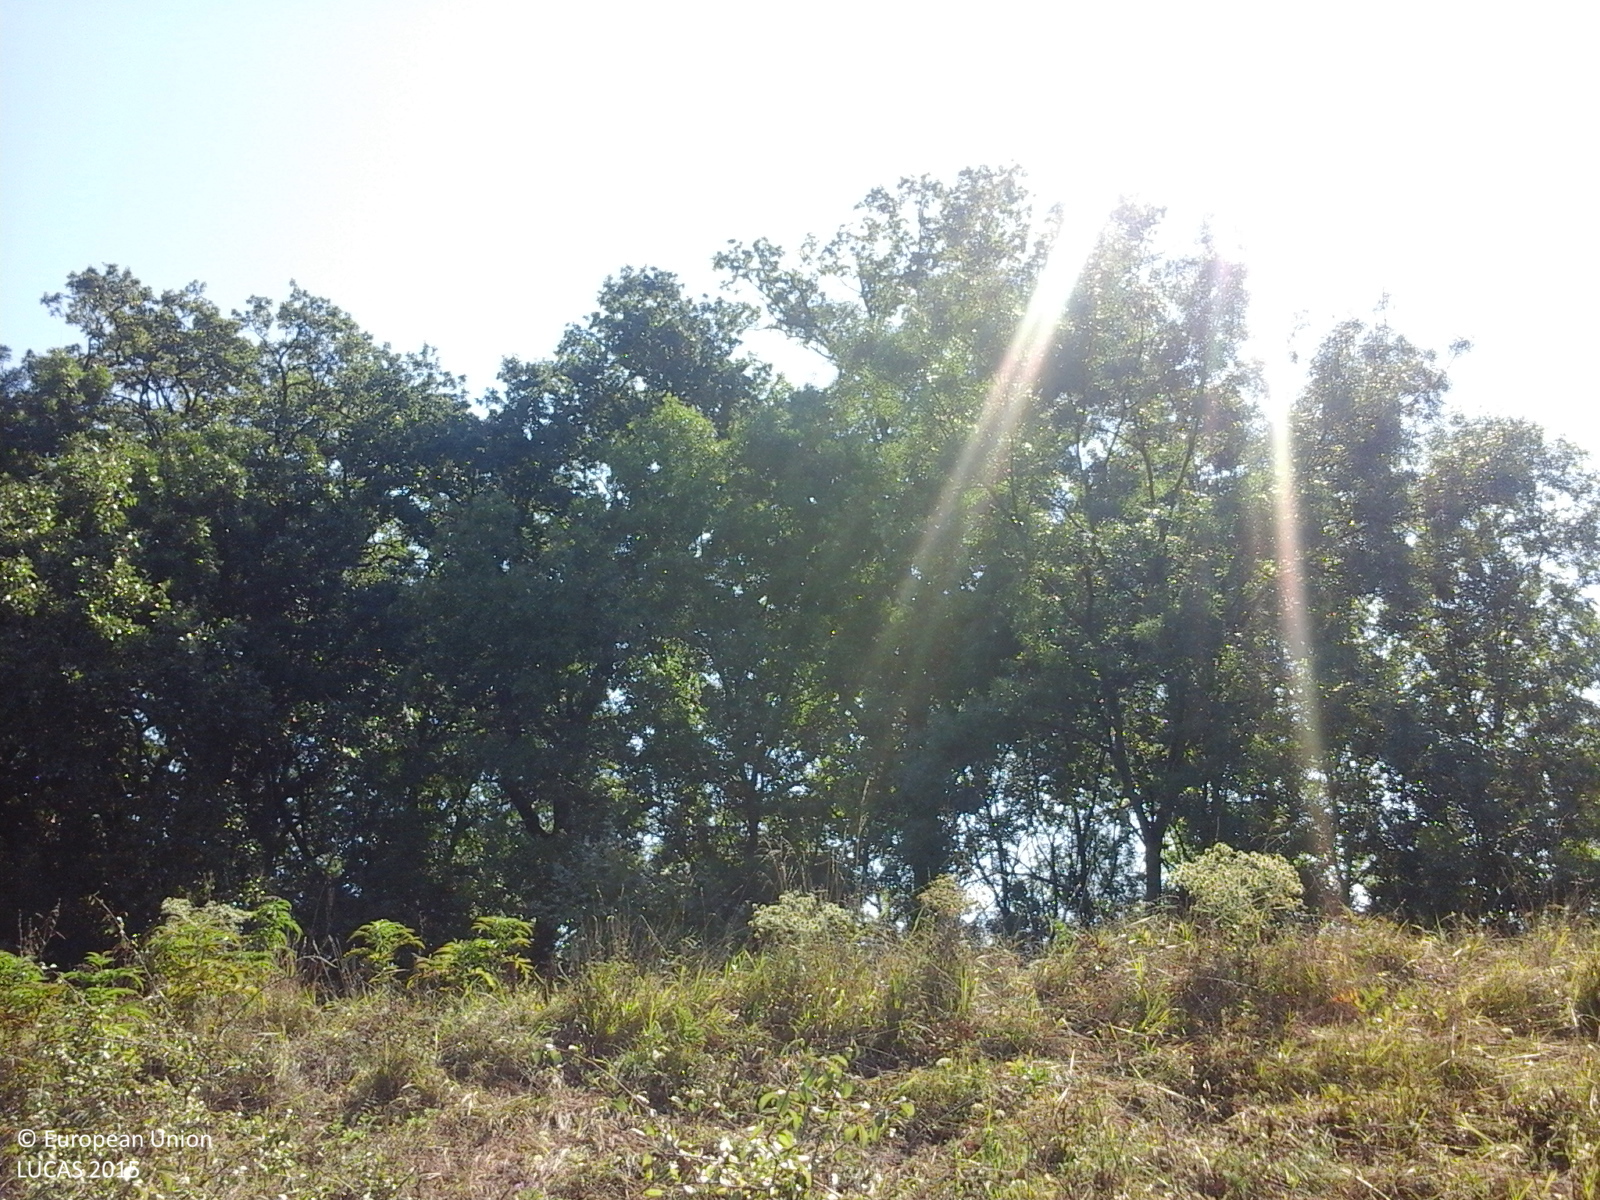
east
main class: Shrubland
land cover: Shrubland with sparse tree cover
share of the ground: > 75 %
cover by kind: shrubs 95 %, broadleaved forest trees 5 %
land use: Semi-natural and natural areas not in use
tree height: < 5 m
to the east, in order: Shrubland with sparse tree cover; Spontaneously vegetated surfaces; Grass margins; Tracks; Grass margins; Spontaneously vegetated surfaces; Broadleaved woodland; Spontaneously vegetated surfaces; Broadleaved woodland
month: August
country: RO
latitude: 45.6609
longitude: 21.2863
